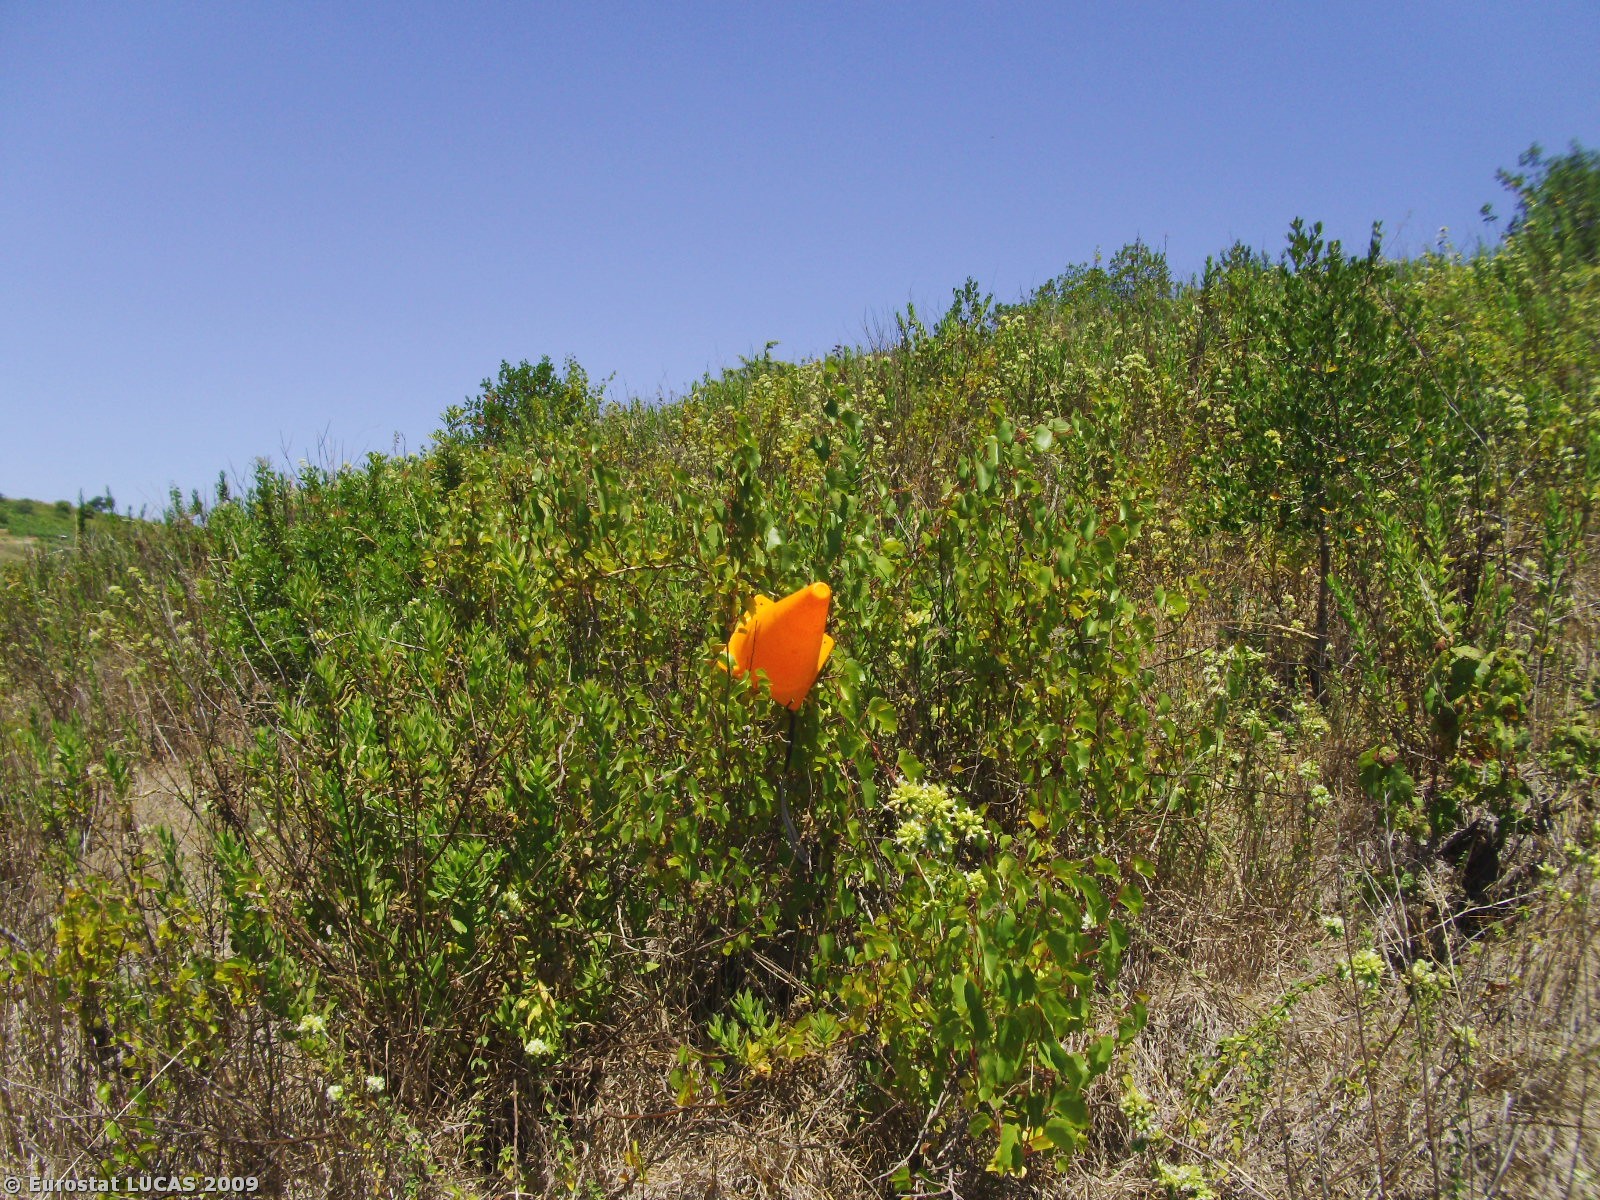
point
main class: Shrubland
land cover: Shrubland without tree cover
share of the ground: > 75 %
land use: Unused
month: July
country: PT
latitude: 39.0851
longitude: -9.0509
